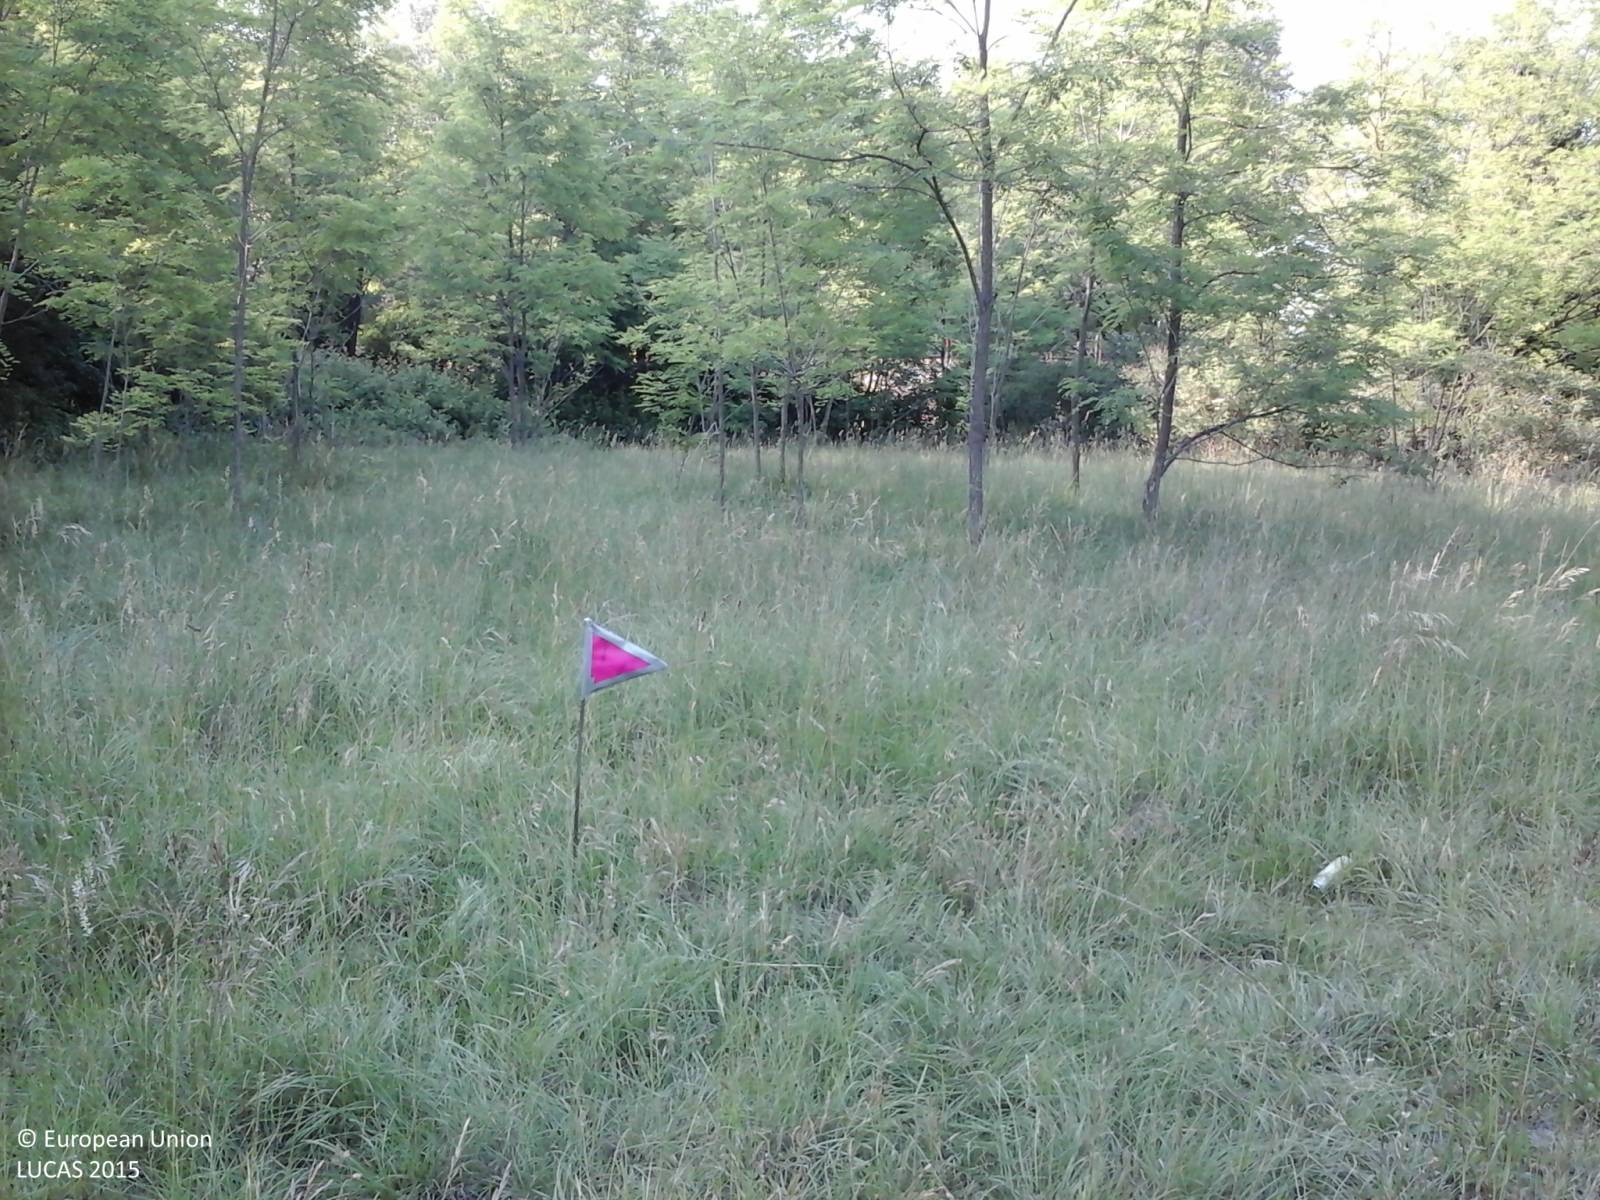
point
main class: Grassland
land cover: Grassland with sparse tree/shrub cover
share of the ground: > 75 %
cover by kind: herbaceous plants 95 %, broadleaved forest trees 5 %
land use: Semi-natural and natural areas not in use
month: May
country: IT
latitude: 45.8094
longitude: 13.4318
